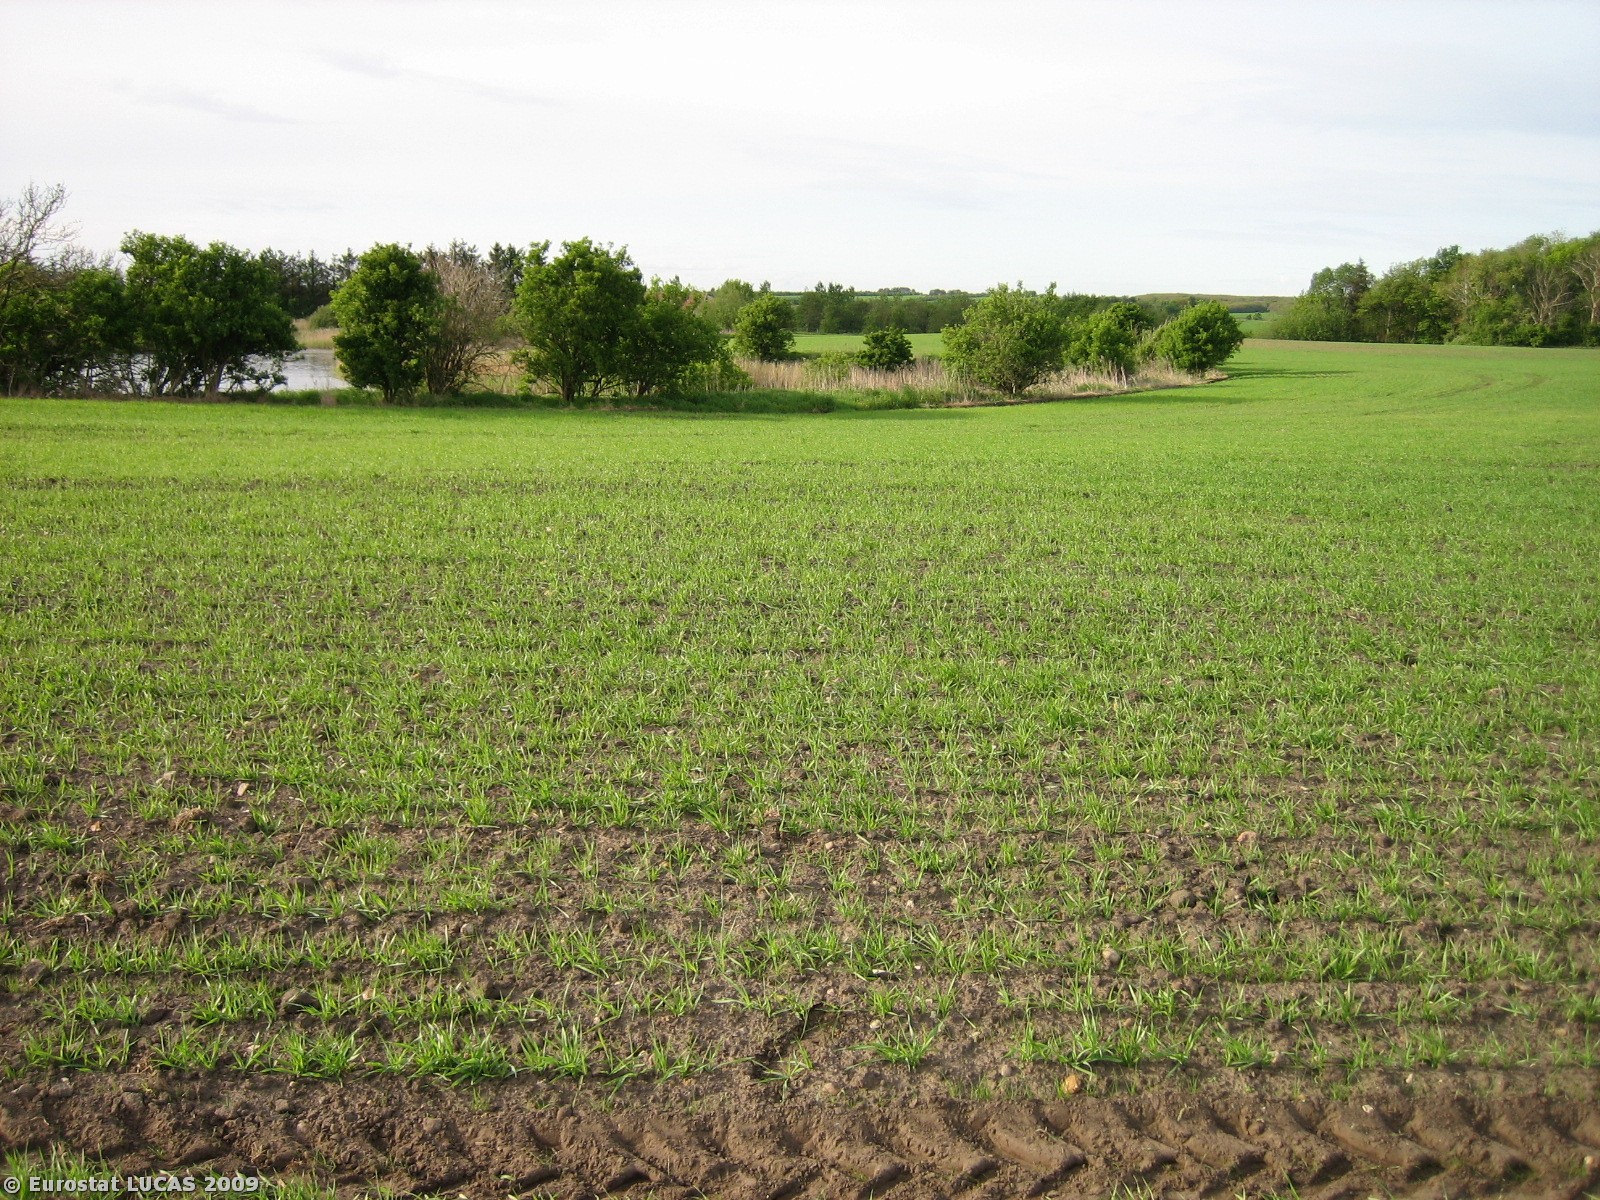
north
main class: Cropland
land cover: Barley
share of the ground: 25 - 50 %
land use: Agriculture (excluding fallow land and kitchen gardens)
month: May
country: DK
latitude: 56.1060
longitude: 8.4099
